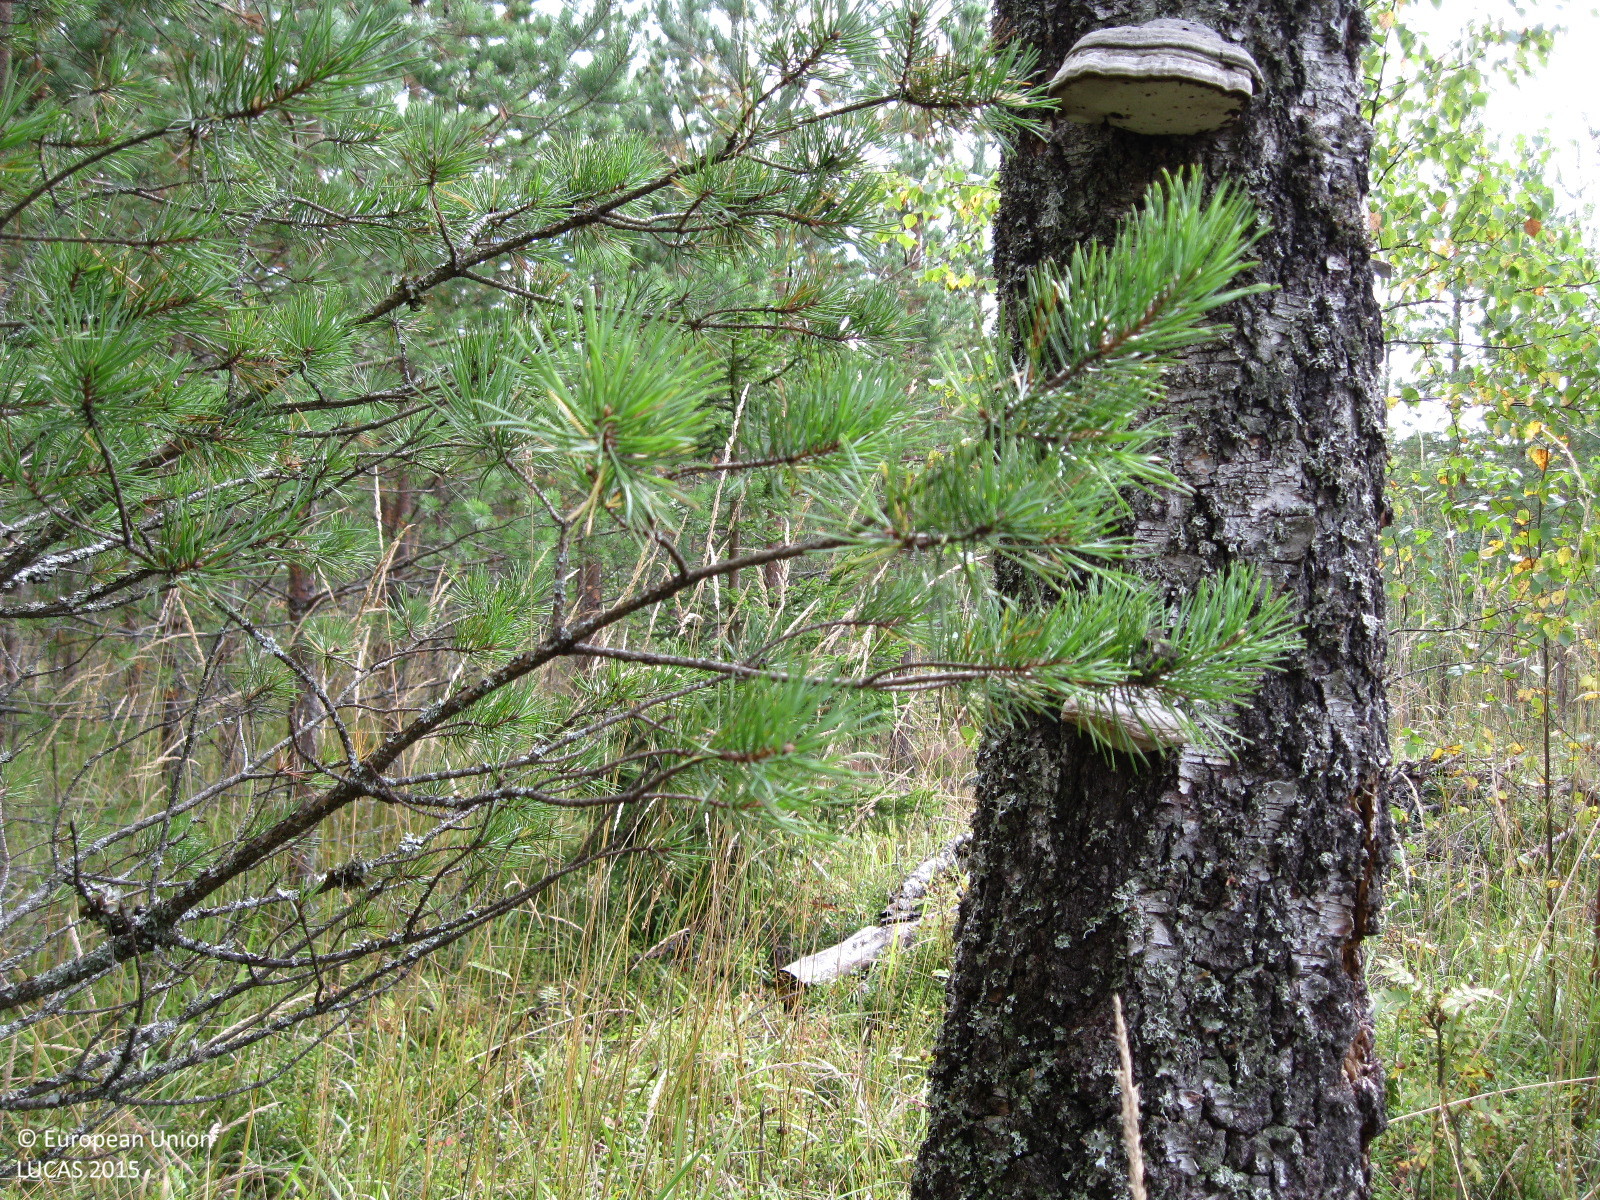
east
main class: Woodland
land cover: Pine dominated mixed woodland
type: boreal forest
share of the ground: 50 - 75 %
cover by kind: coniferous forest trees 50 %, broadleaved forest trees 20 %, herbaceous plants 20 %, shrubs 10 %
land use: Forestry
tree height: > 5 m
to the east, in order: Pine dominated mixed woodland; Spruce dominated mixed woodland; Spontaneously vegetated surfaces; Electric lines; Spontaneously vegetated surfaces; Spruce dominated mixed woodland; Paved roads, cycling and walking lanes; Spruce dominated mixed woodland; Tracks
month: September
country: FI
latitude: 60.5140
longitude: 24.6250
